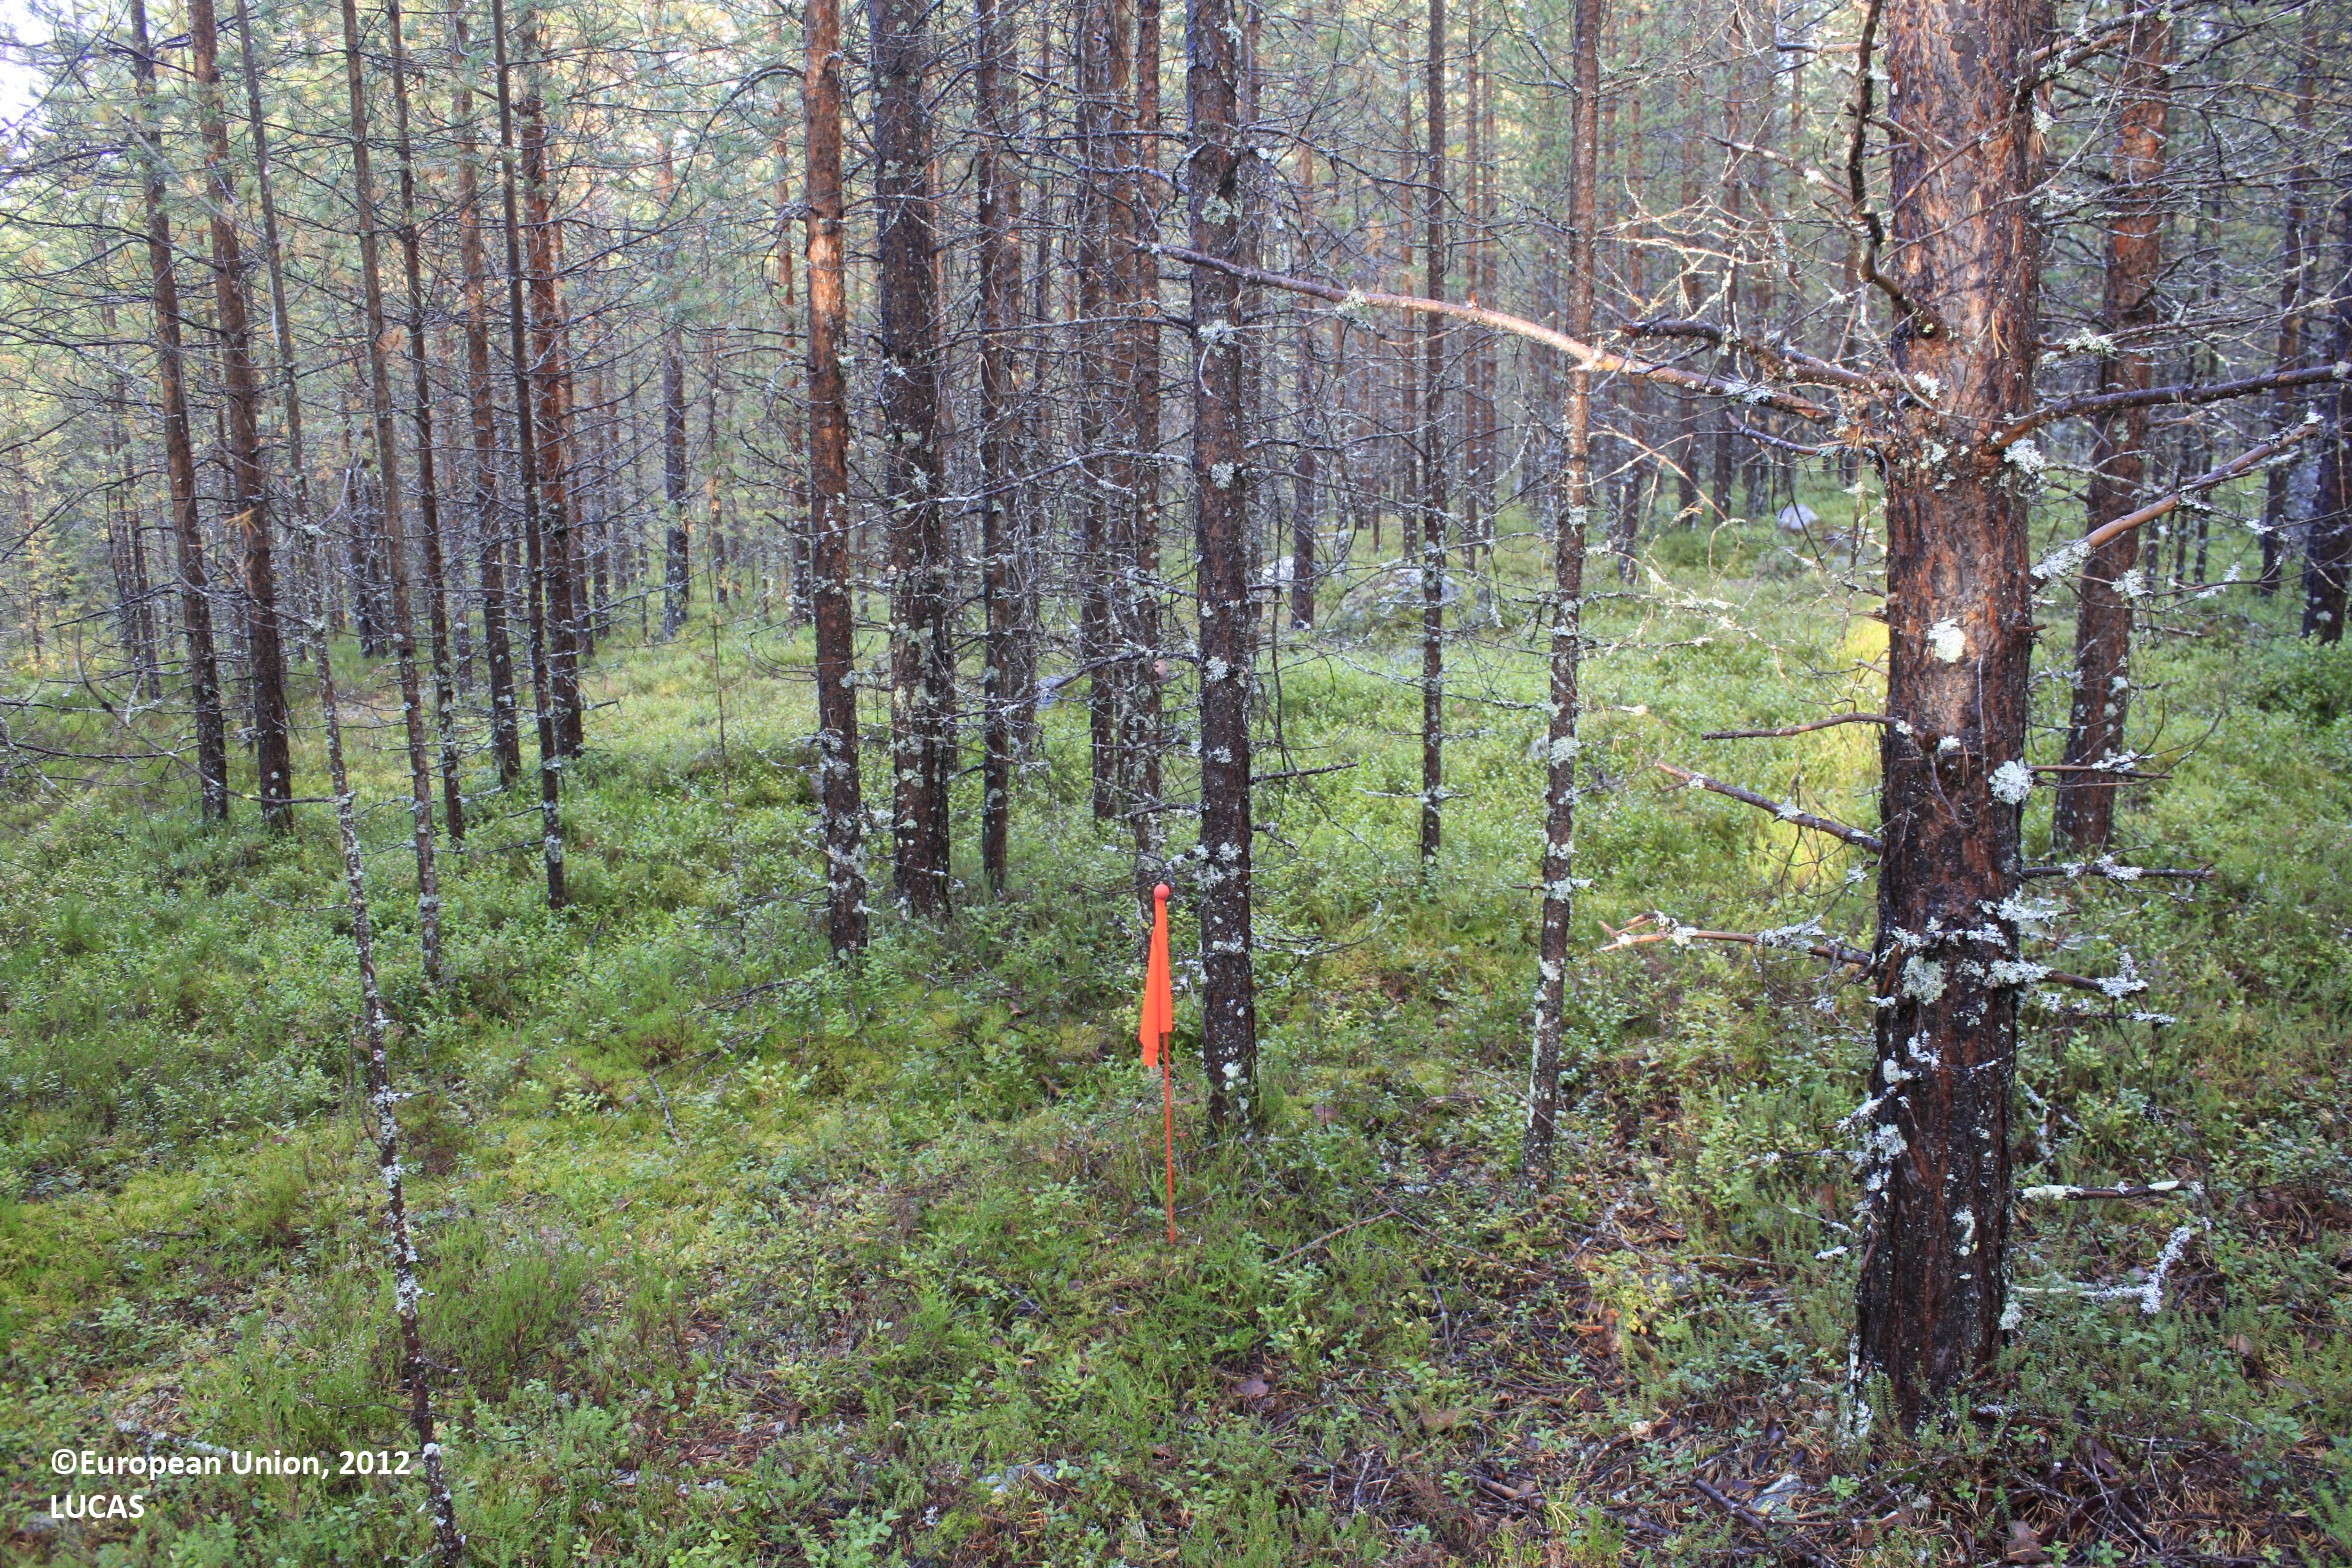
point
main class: Woodland
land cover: Pine dominated coniferous woodland
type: boreal forest
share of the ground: 50 - 75 %
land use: Forestry
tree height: > 5 m
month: September
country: FI
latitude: 65.2621
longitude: 26.9282
